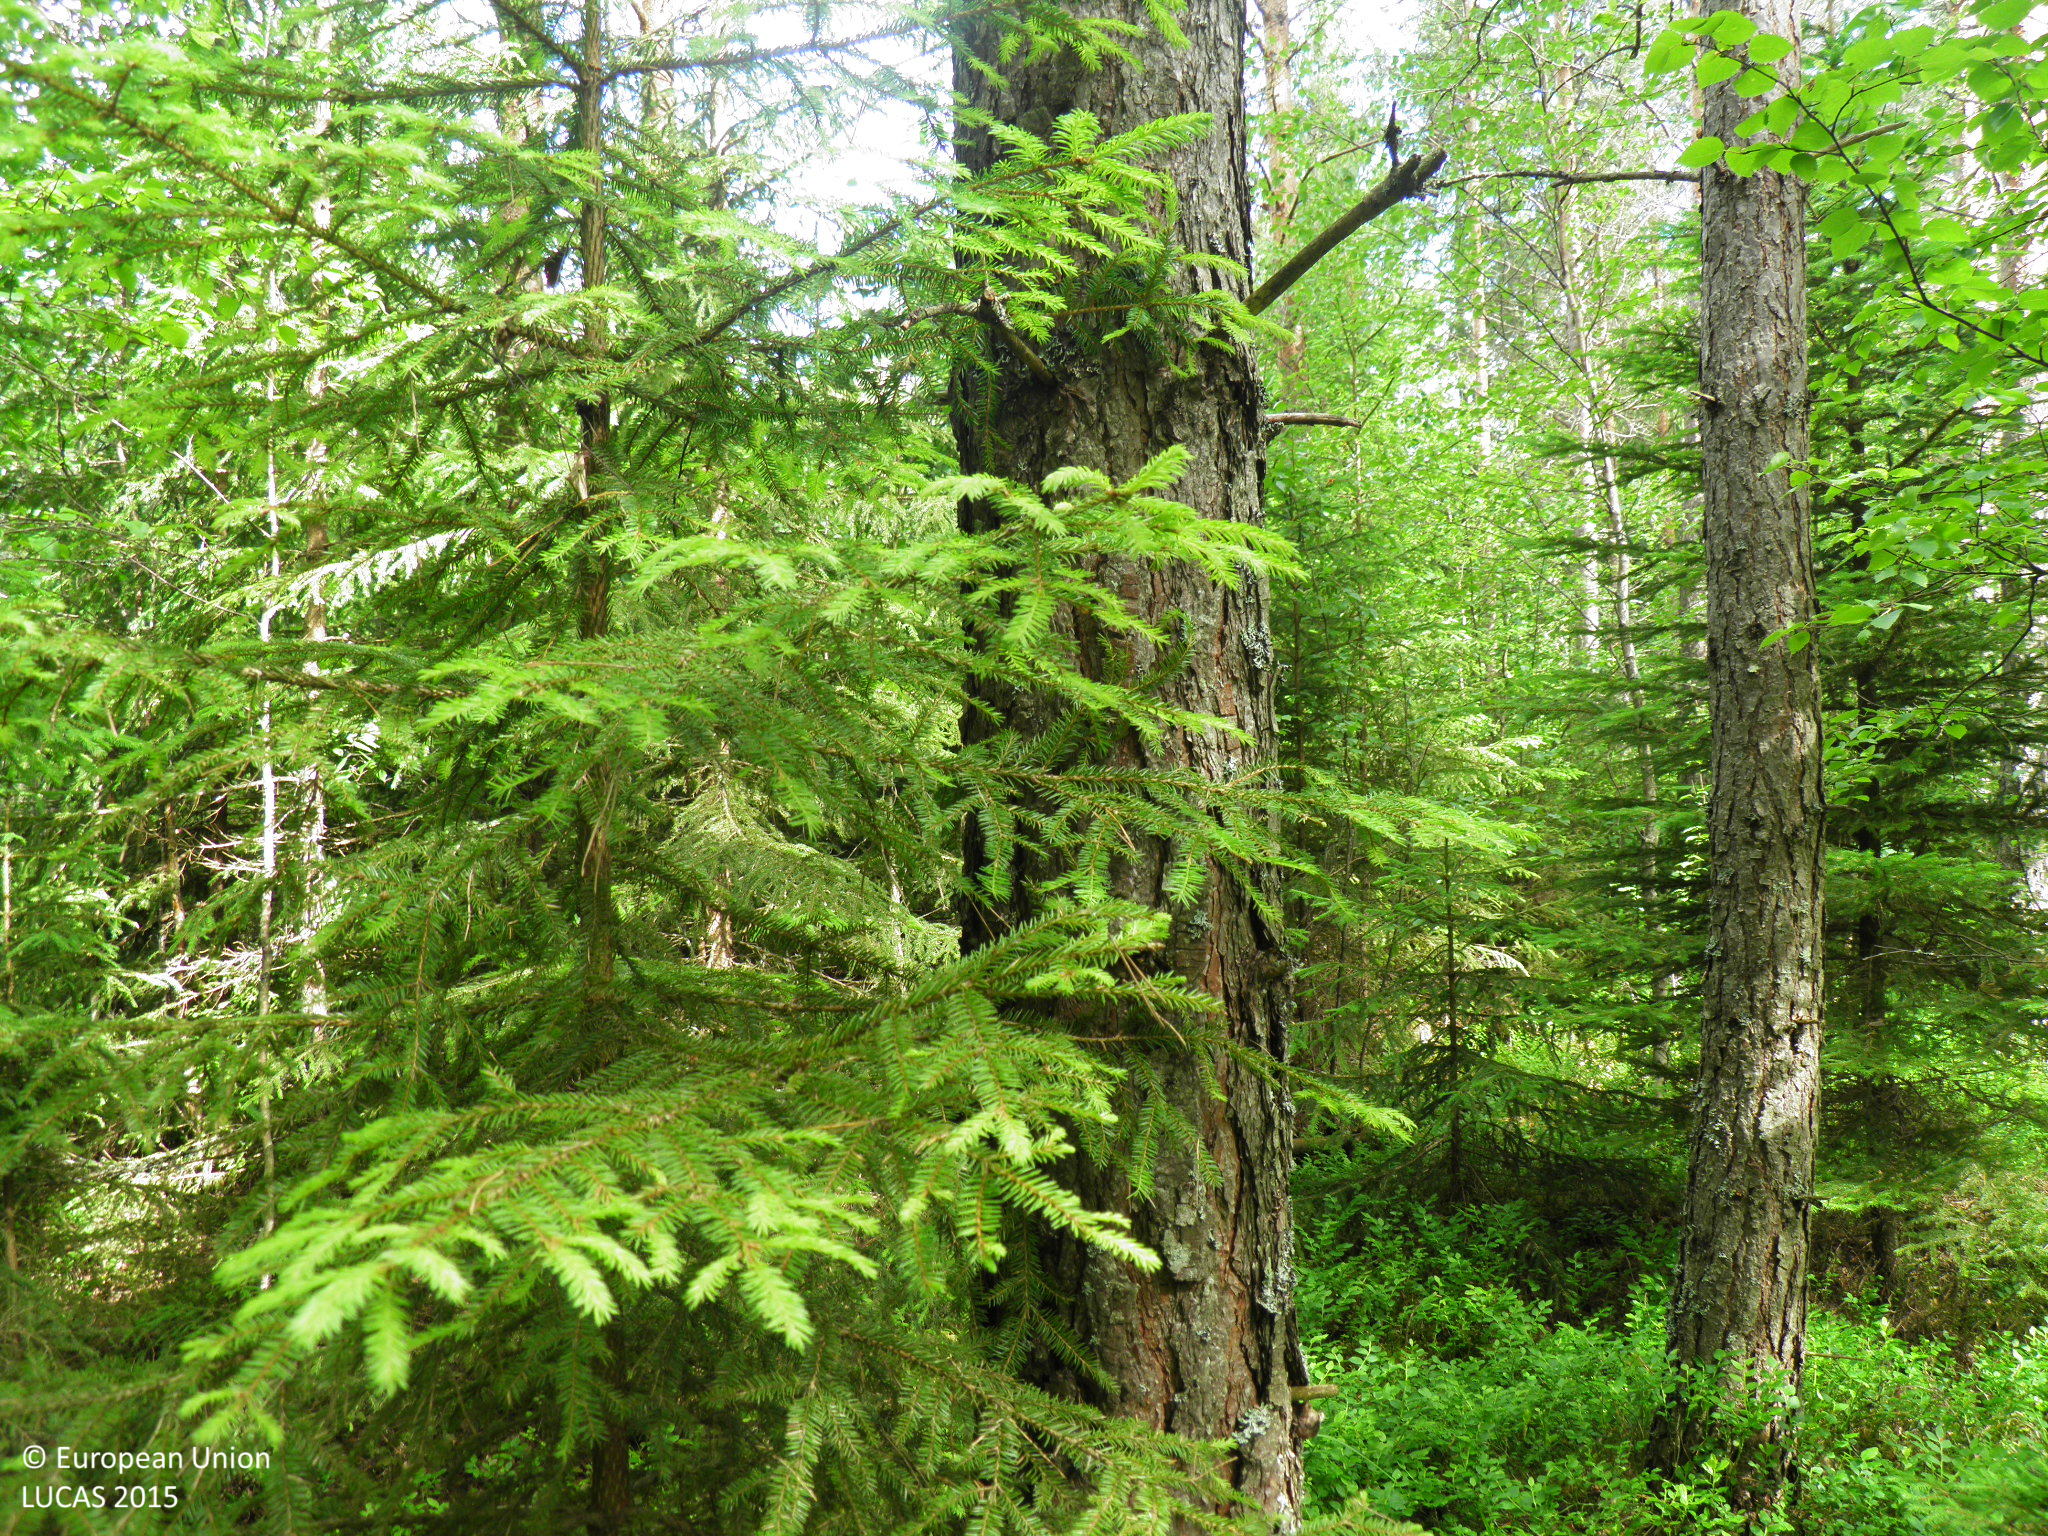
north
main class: Woodland
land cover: Pine dominated coniferous woodland
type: hemiboreal forest and nemoral coniferous forest and mixed broadleaved-coniferous forest
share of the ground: > 75 %
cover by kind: coniferous forest trees 65 %, broadleaved forest trees 15 %, shrubs 10 %, lichens and mosses 10 %
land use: Forestry
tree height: > 5 m
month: June
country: FI
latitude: 60.3393
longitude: 22.8484
